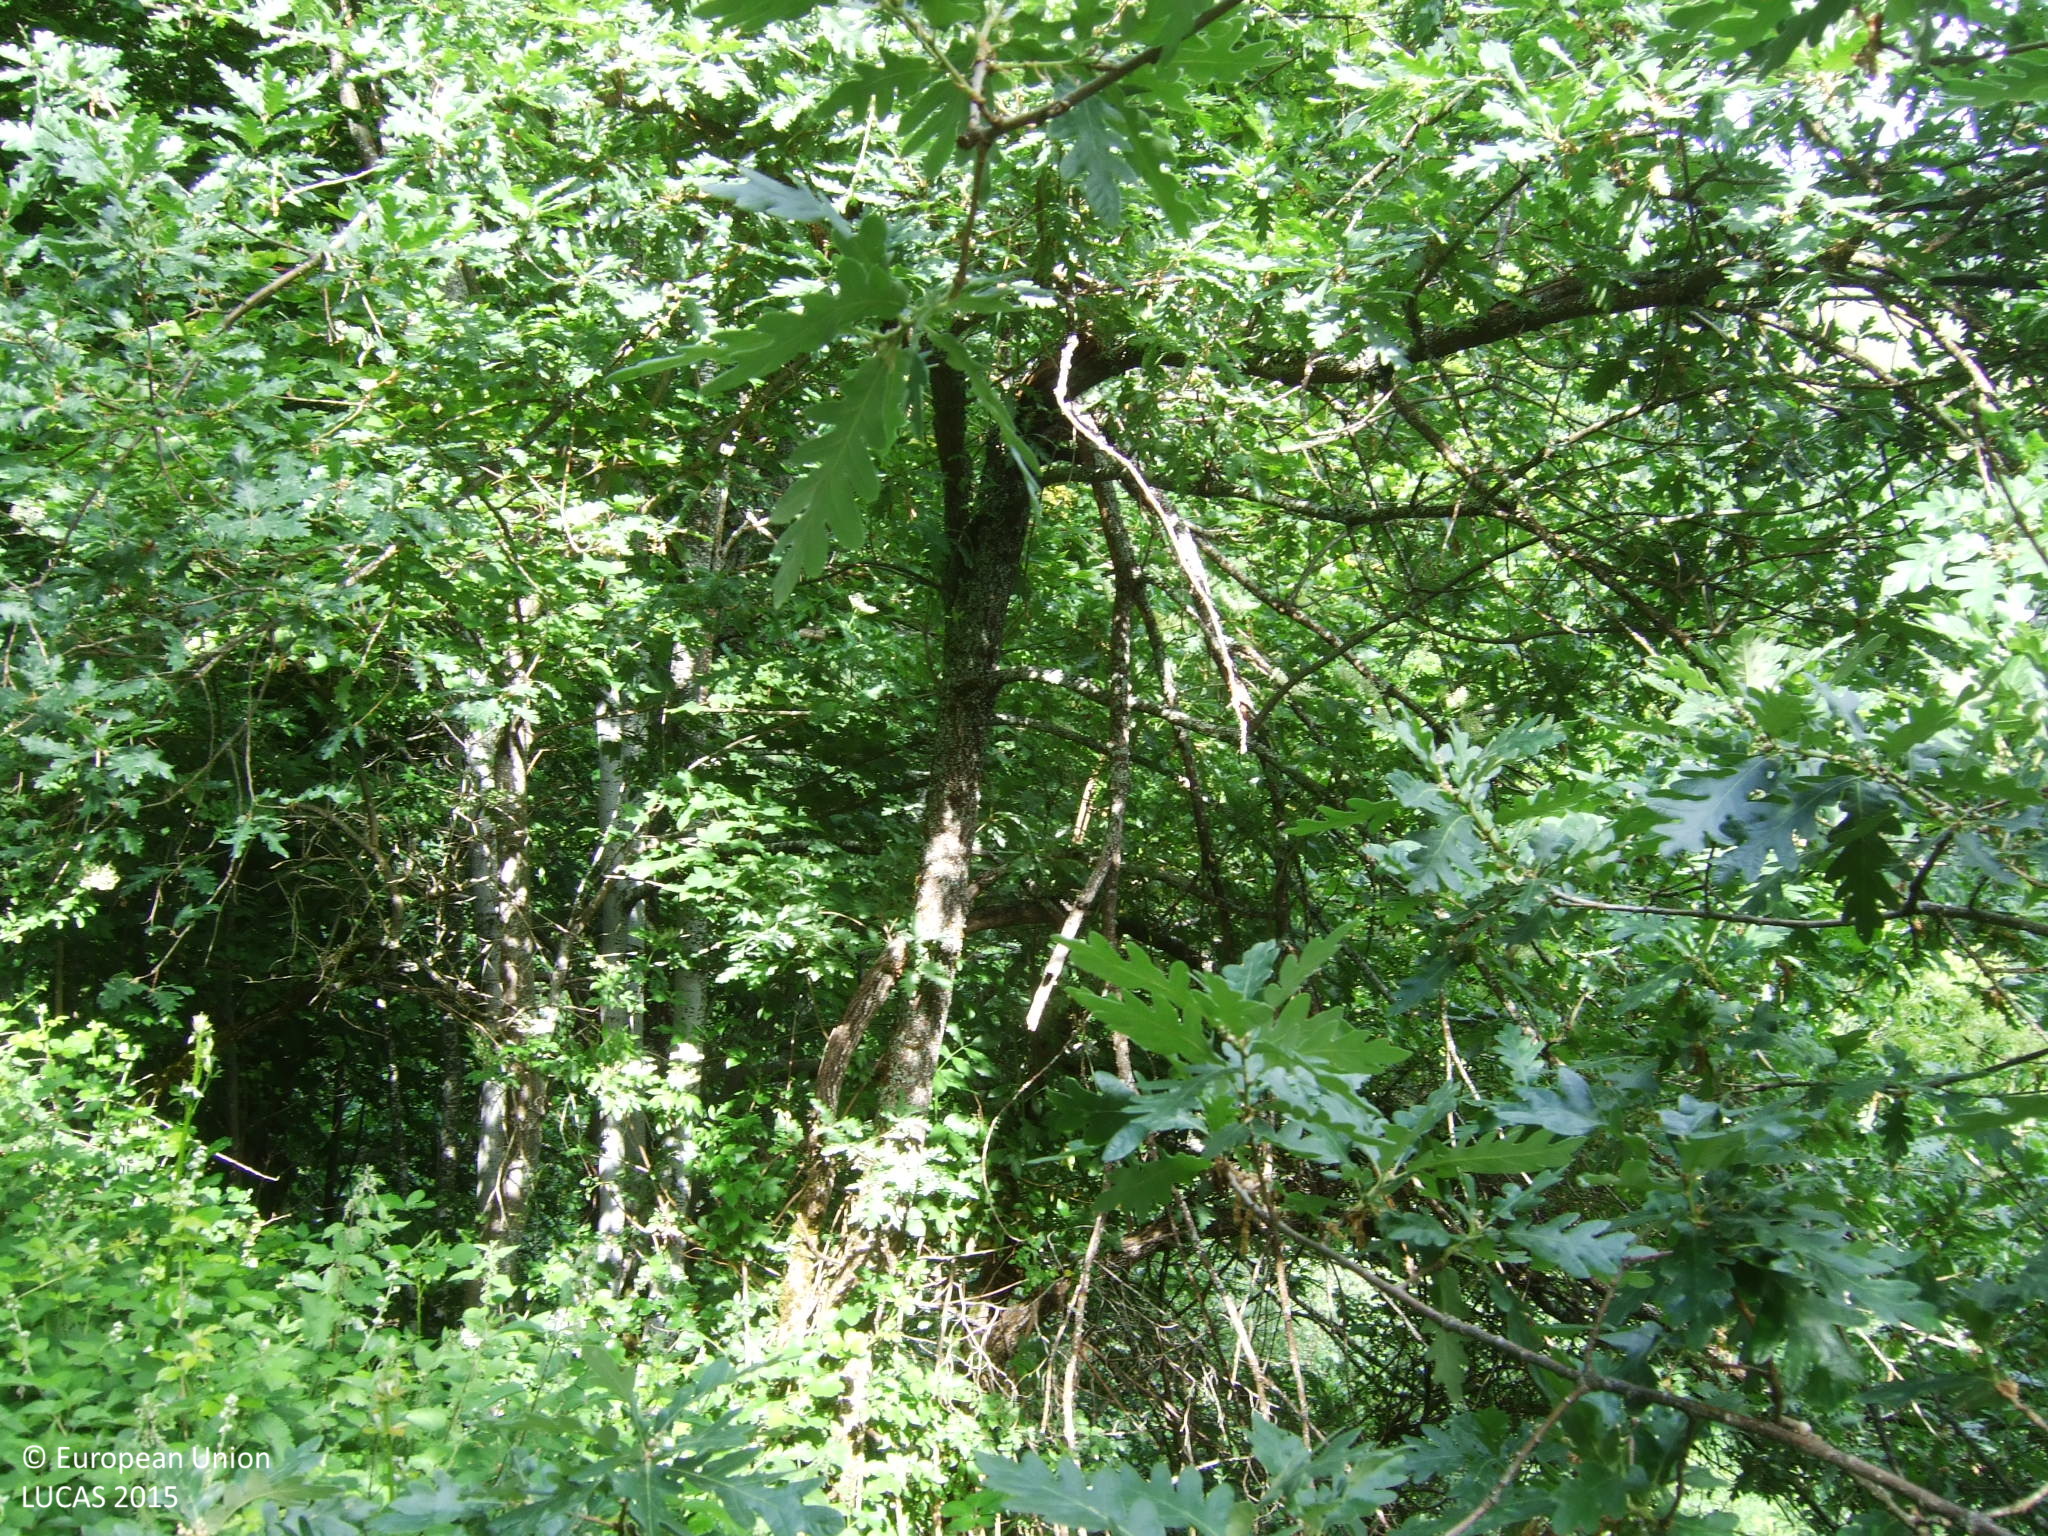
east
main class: Woodland
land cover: Broadleaved woodland
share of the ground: 50 - 75 %
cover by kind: broadleaved forest trees 65 %, shrubs 35 %
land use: Semi-natural and natural areas not in use
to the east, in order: Broadleaved woodland; Paved roads, cycling and walking lanes; Broadleaved woodland; Pine dominated coniferous woodland
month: June
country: ES
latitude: 42.6505
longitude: -7.0507
